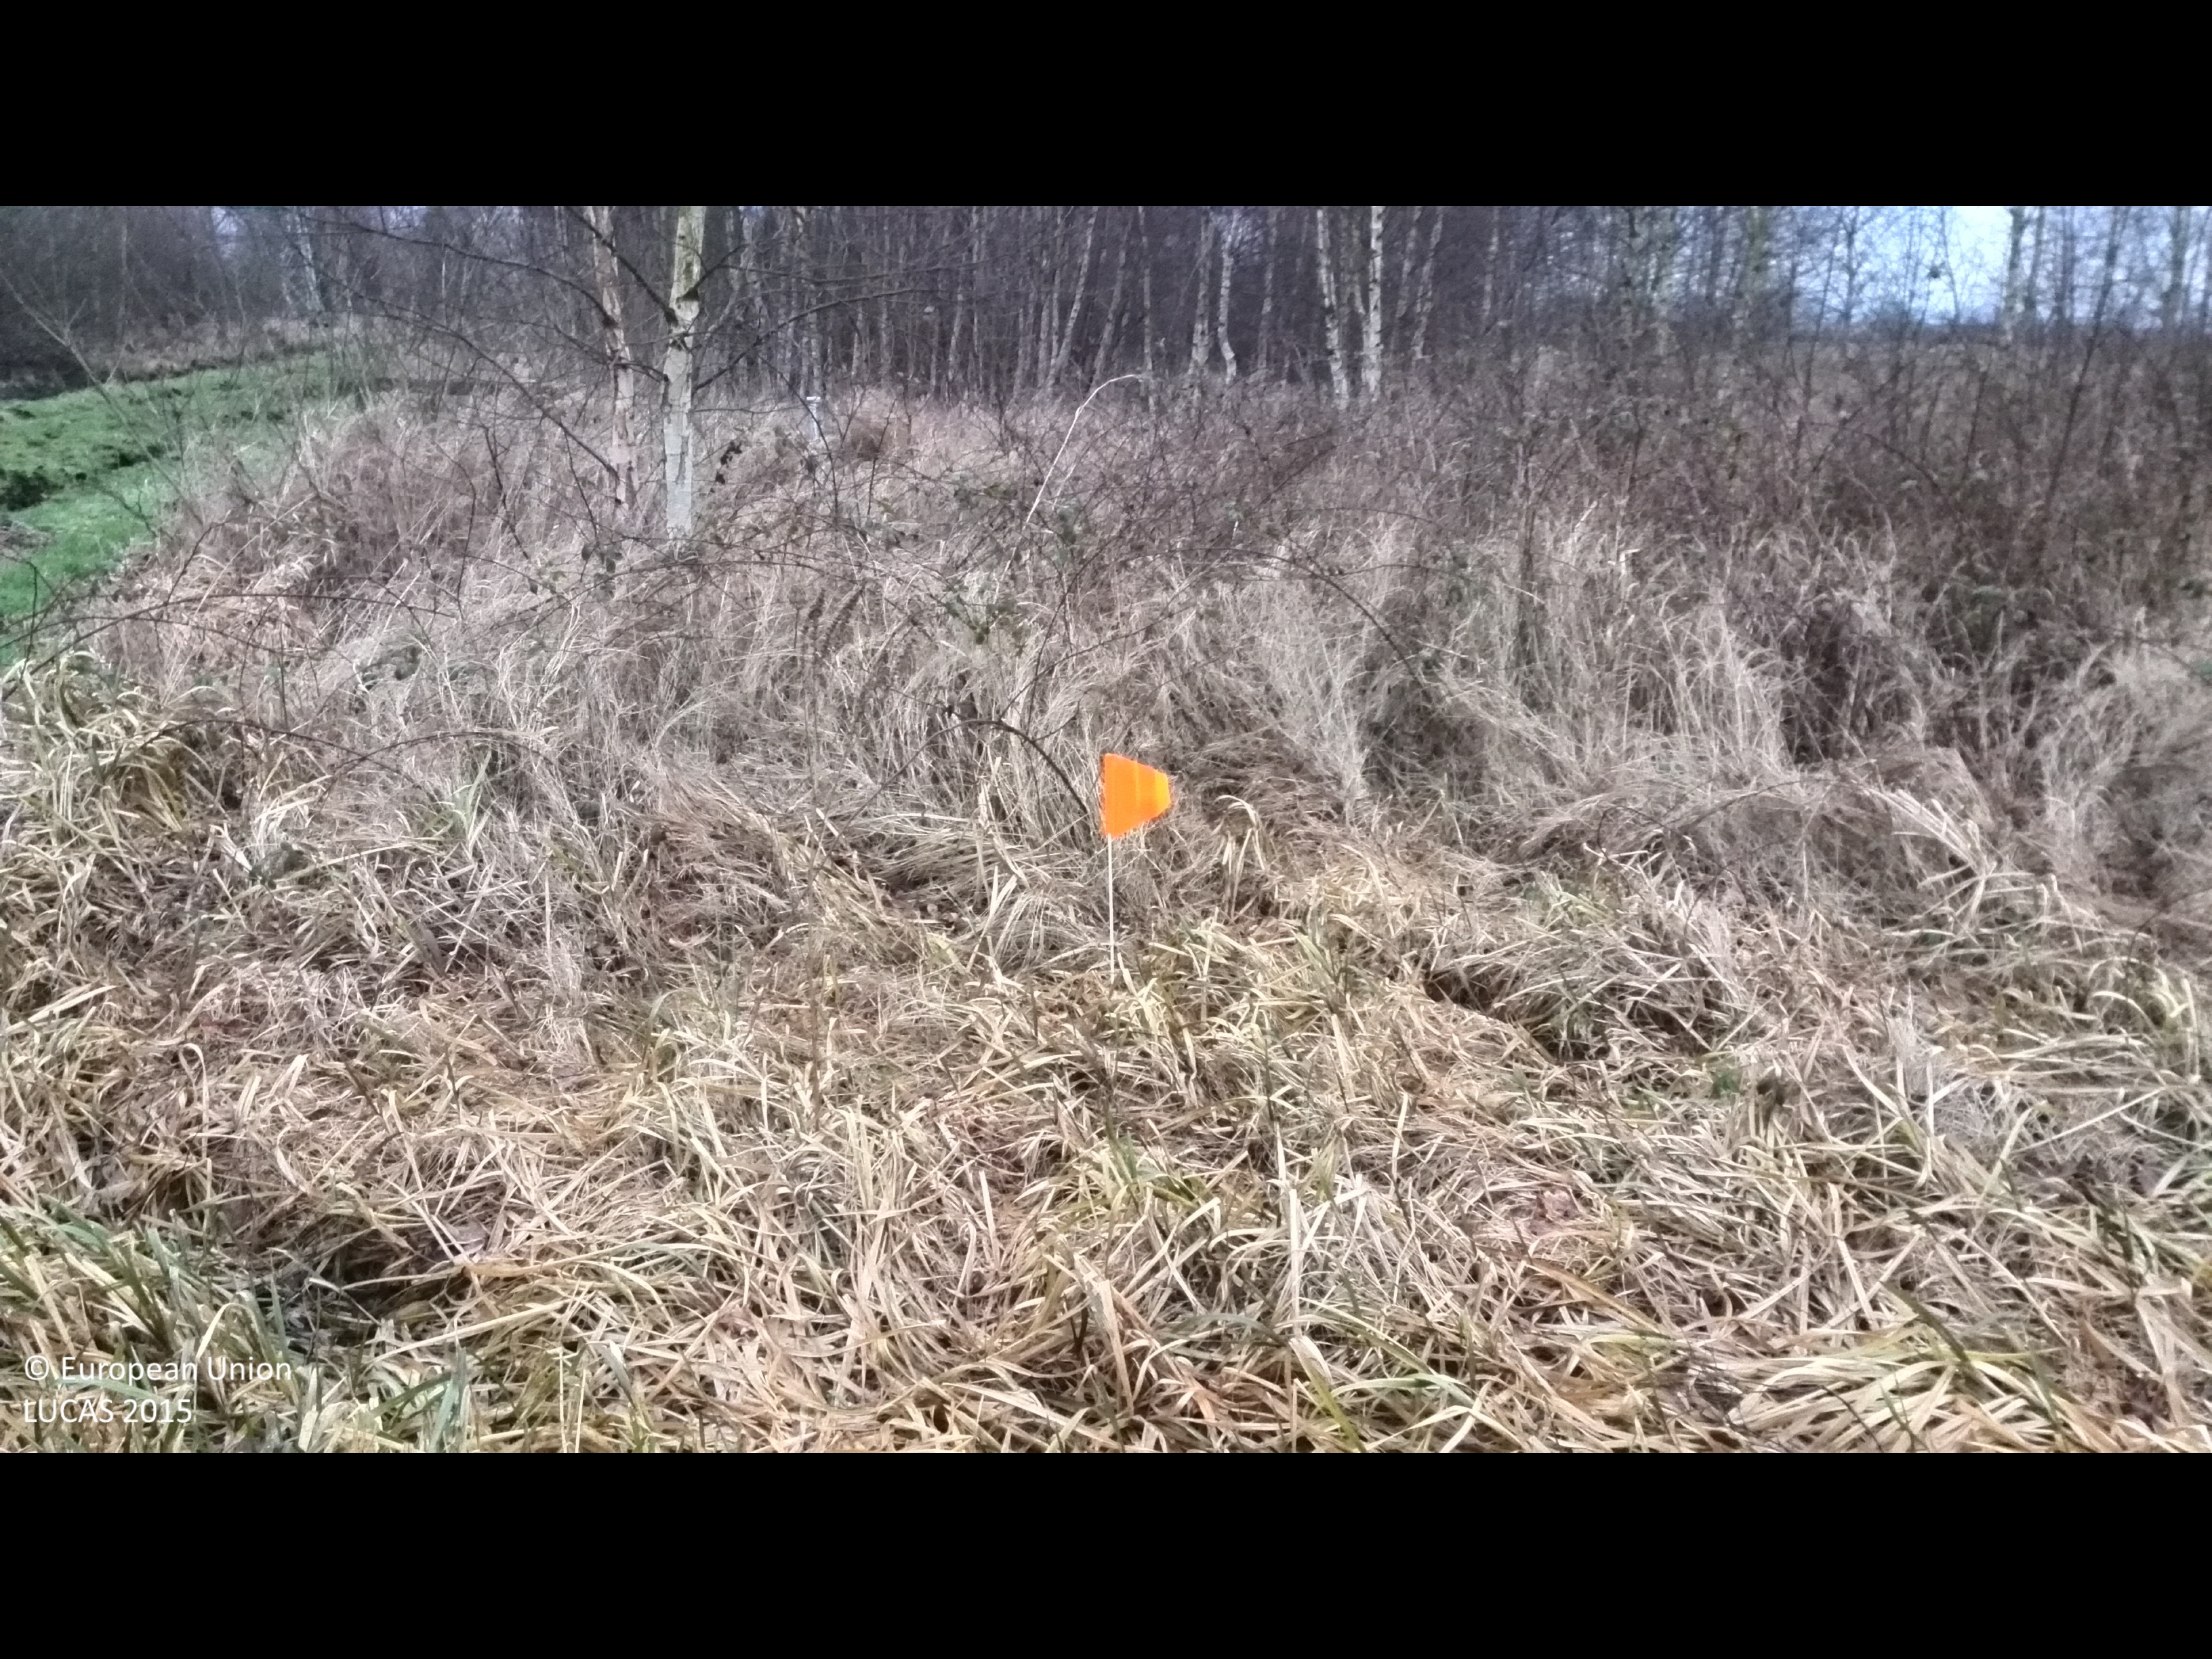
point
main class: Shrubland
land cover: Shrubland with sparse tree cover
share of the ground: > 75 %
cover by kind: shrubs 75 %, herbaceous plants 20 %, broadleaved forest trees 5 %
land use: Semi-natural and natural areas not in use
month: January
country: DE
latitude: 53.4917
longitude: 9.8343
